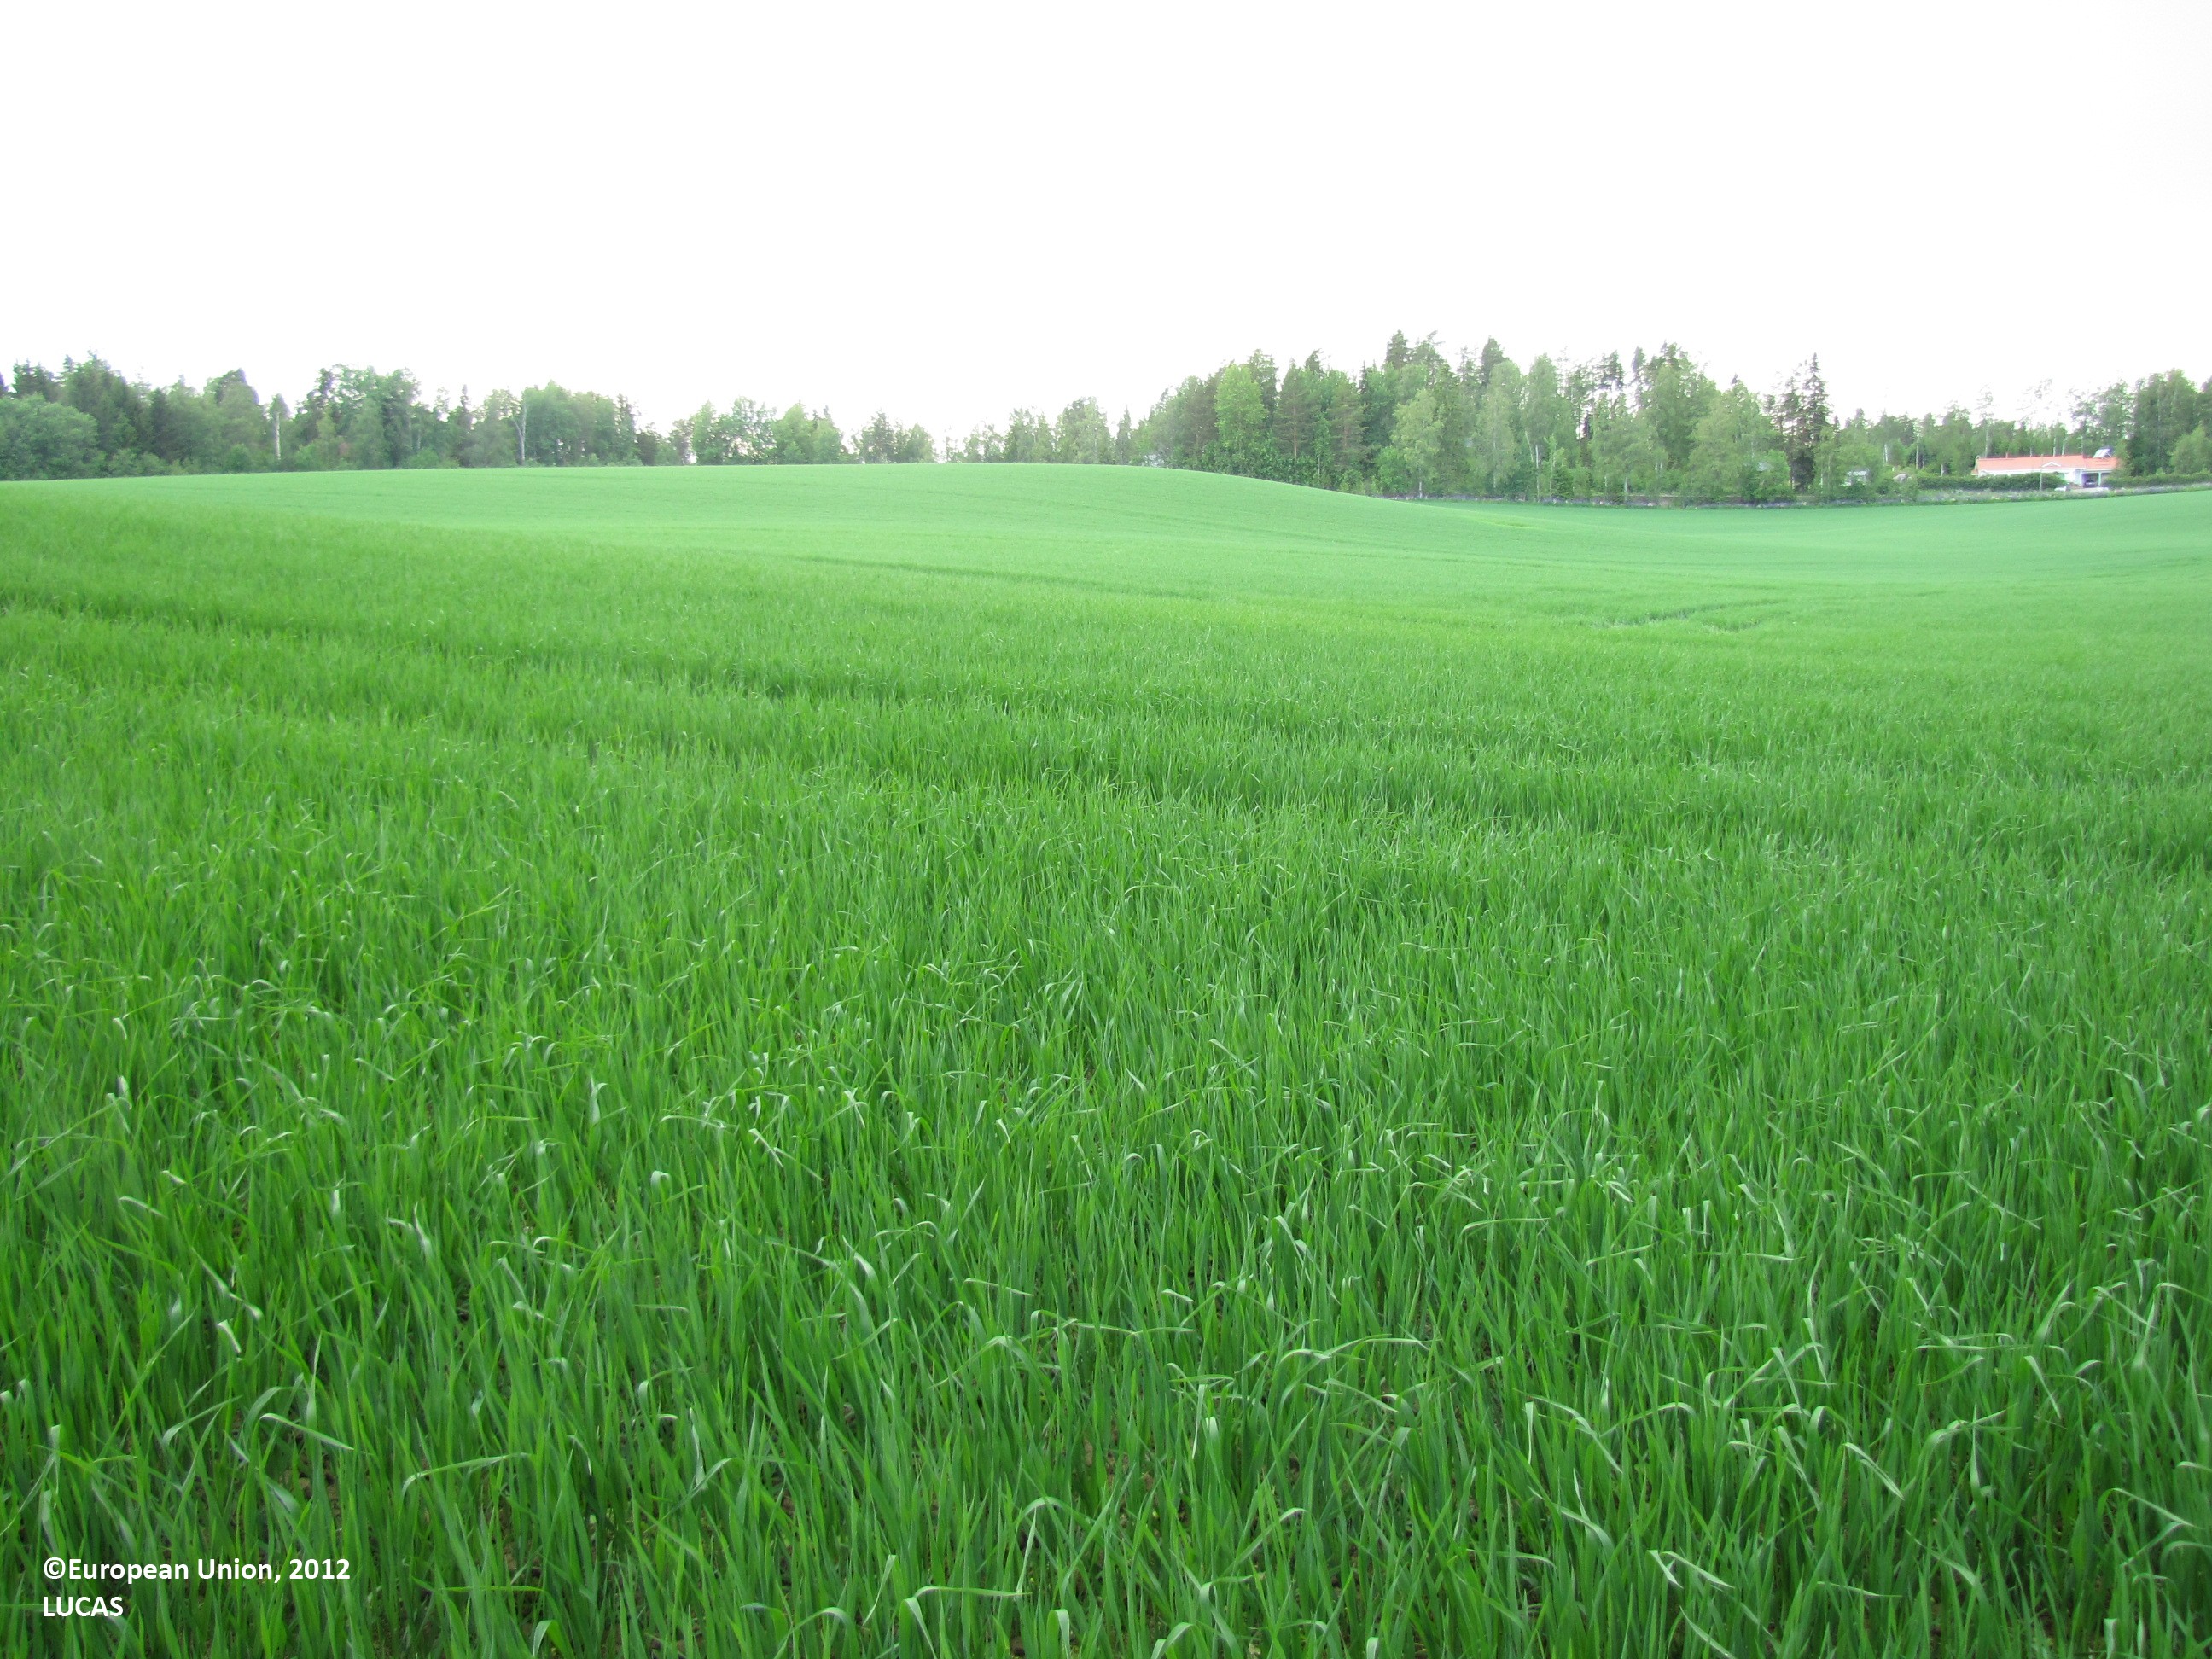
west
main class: Cropland
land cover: Oats
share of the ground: 50 - 75 %
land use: Agriculture (excluding fallow land and kitchen gardens)
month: June
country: FI
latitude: 61.6939
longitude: 24.4056
